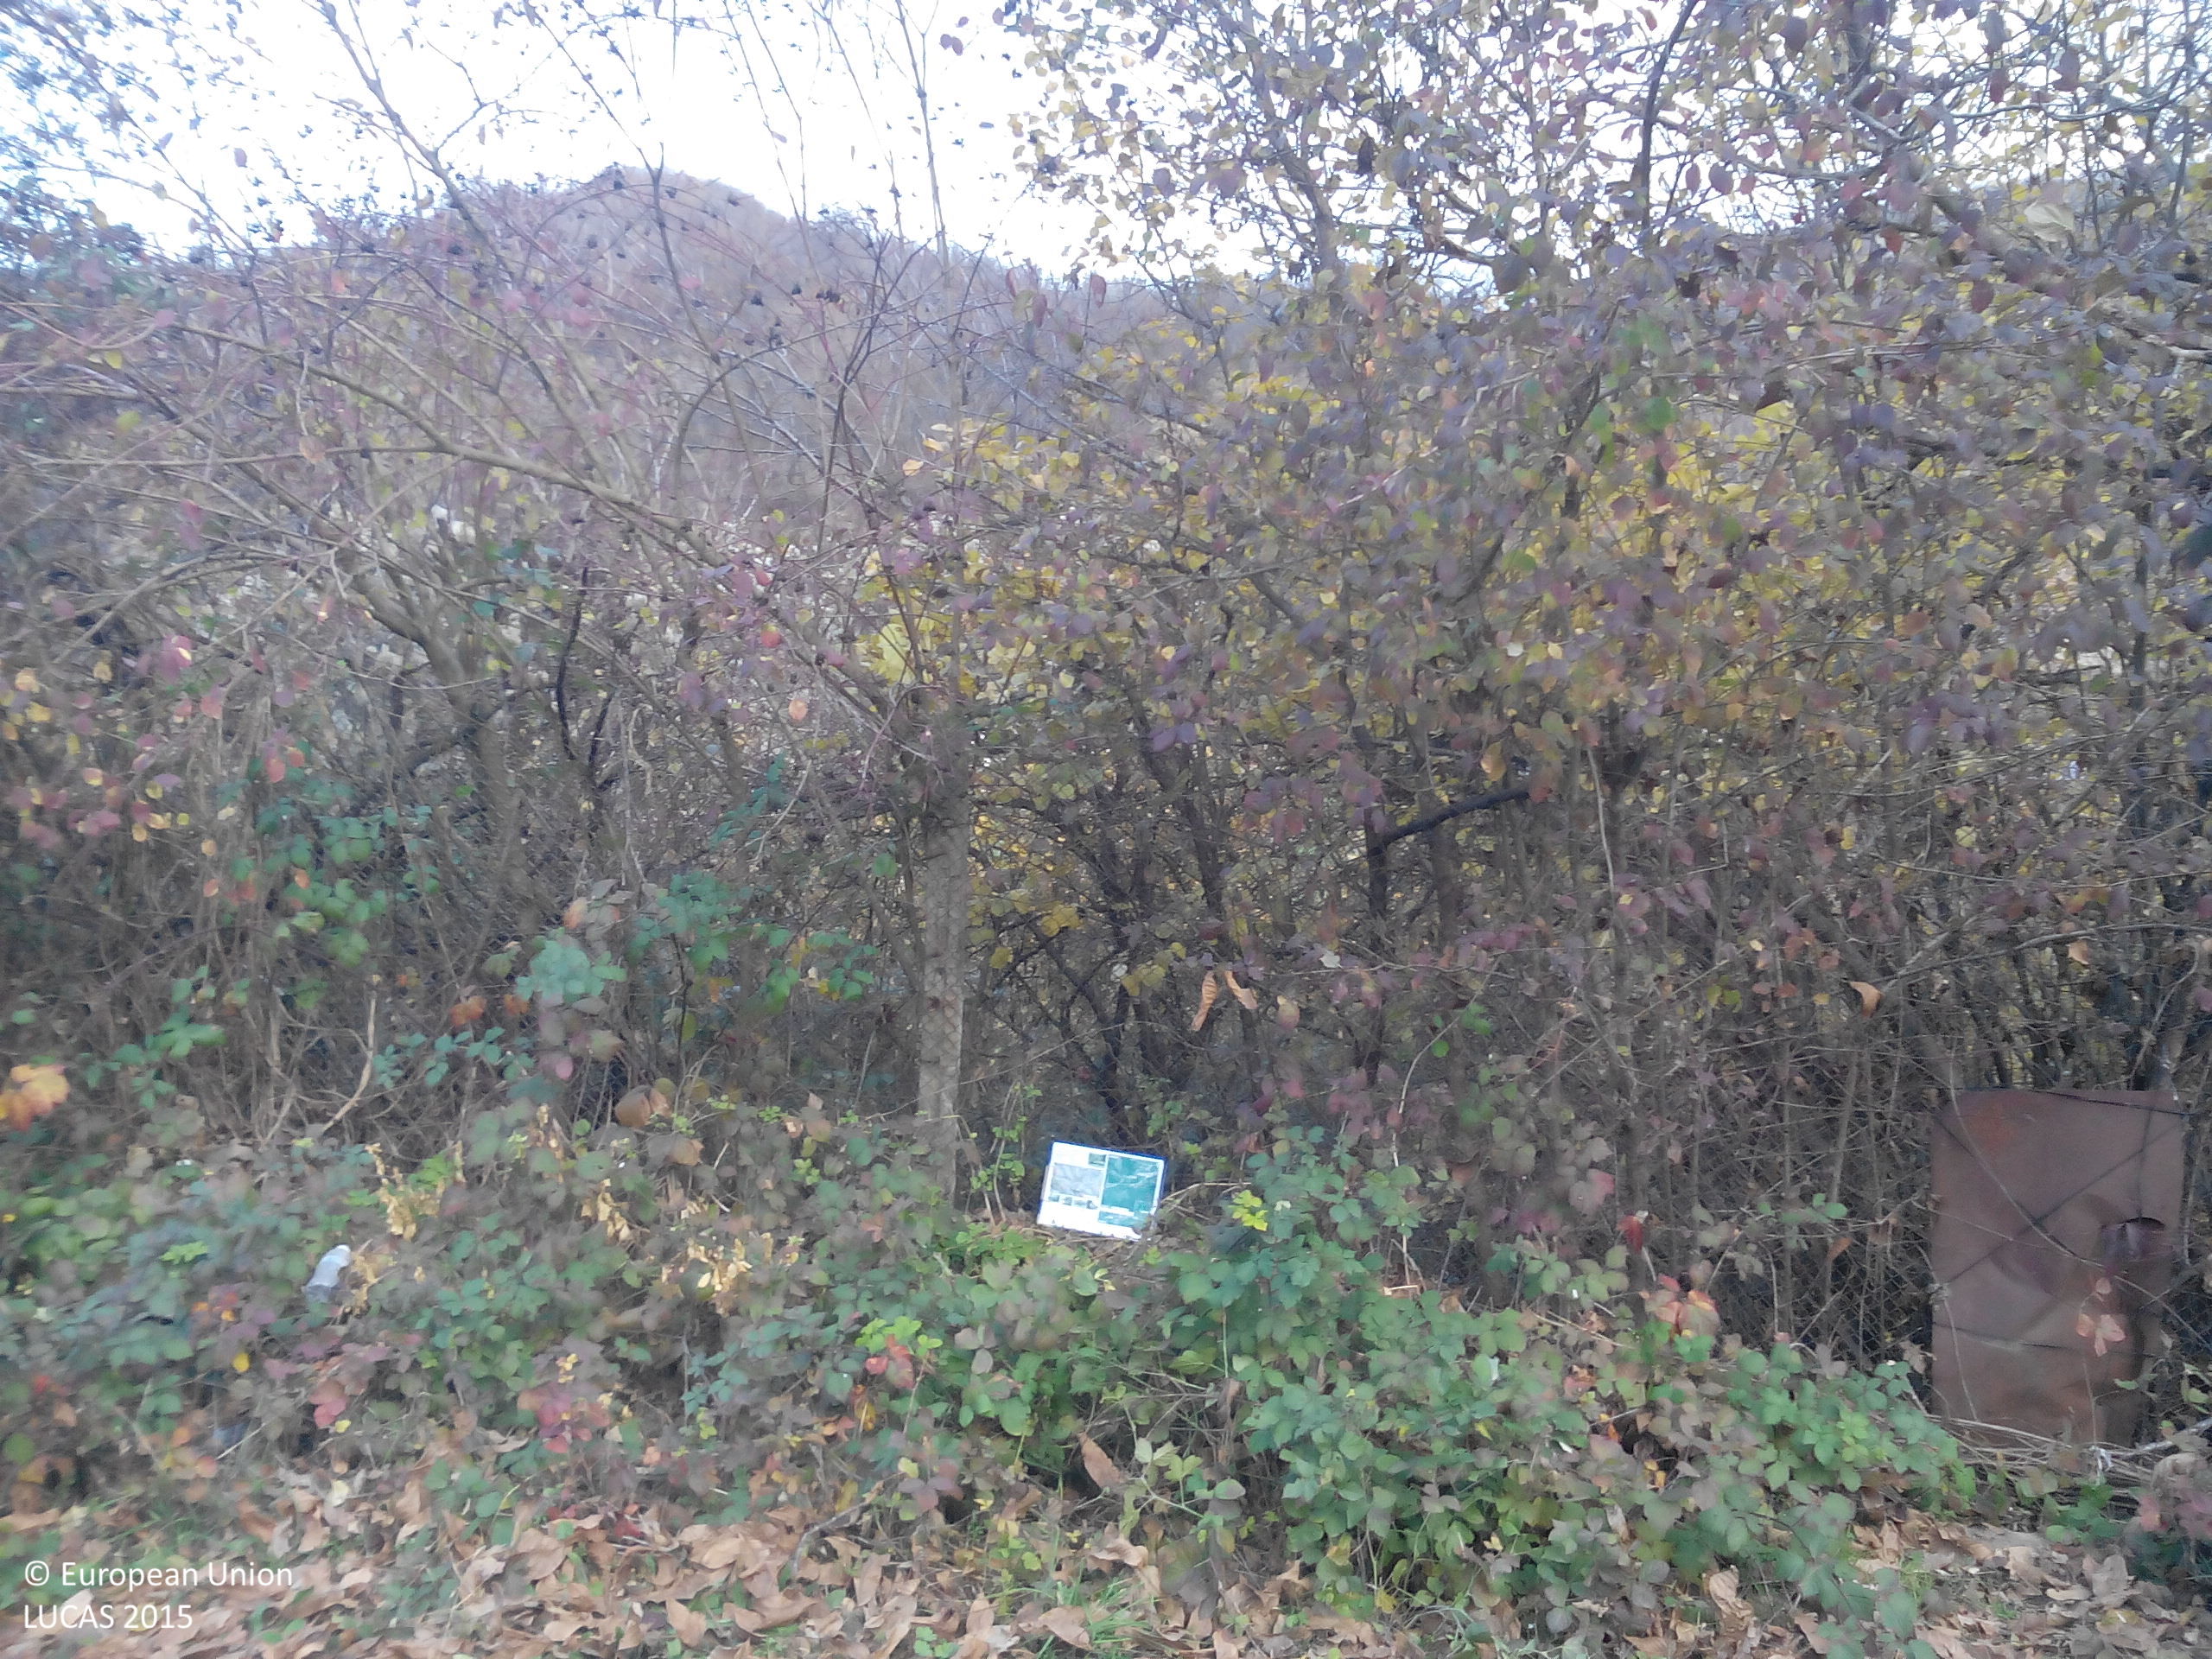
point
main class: Woodland
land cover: Broadleaved woodland
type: mesophytic deciduous forest
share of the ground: > 75 %
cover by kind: broadleaved forest trees 85 %, herbaceous plants 10 %, shrubs 5 %
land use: Residential
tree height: > 5 m
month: November
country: BG
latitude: 43.0277
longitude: 23.7522
